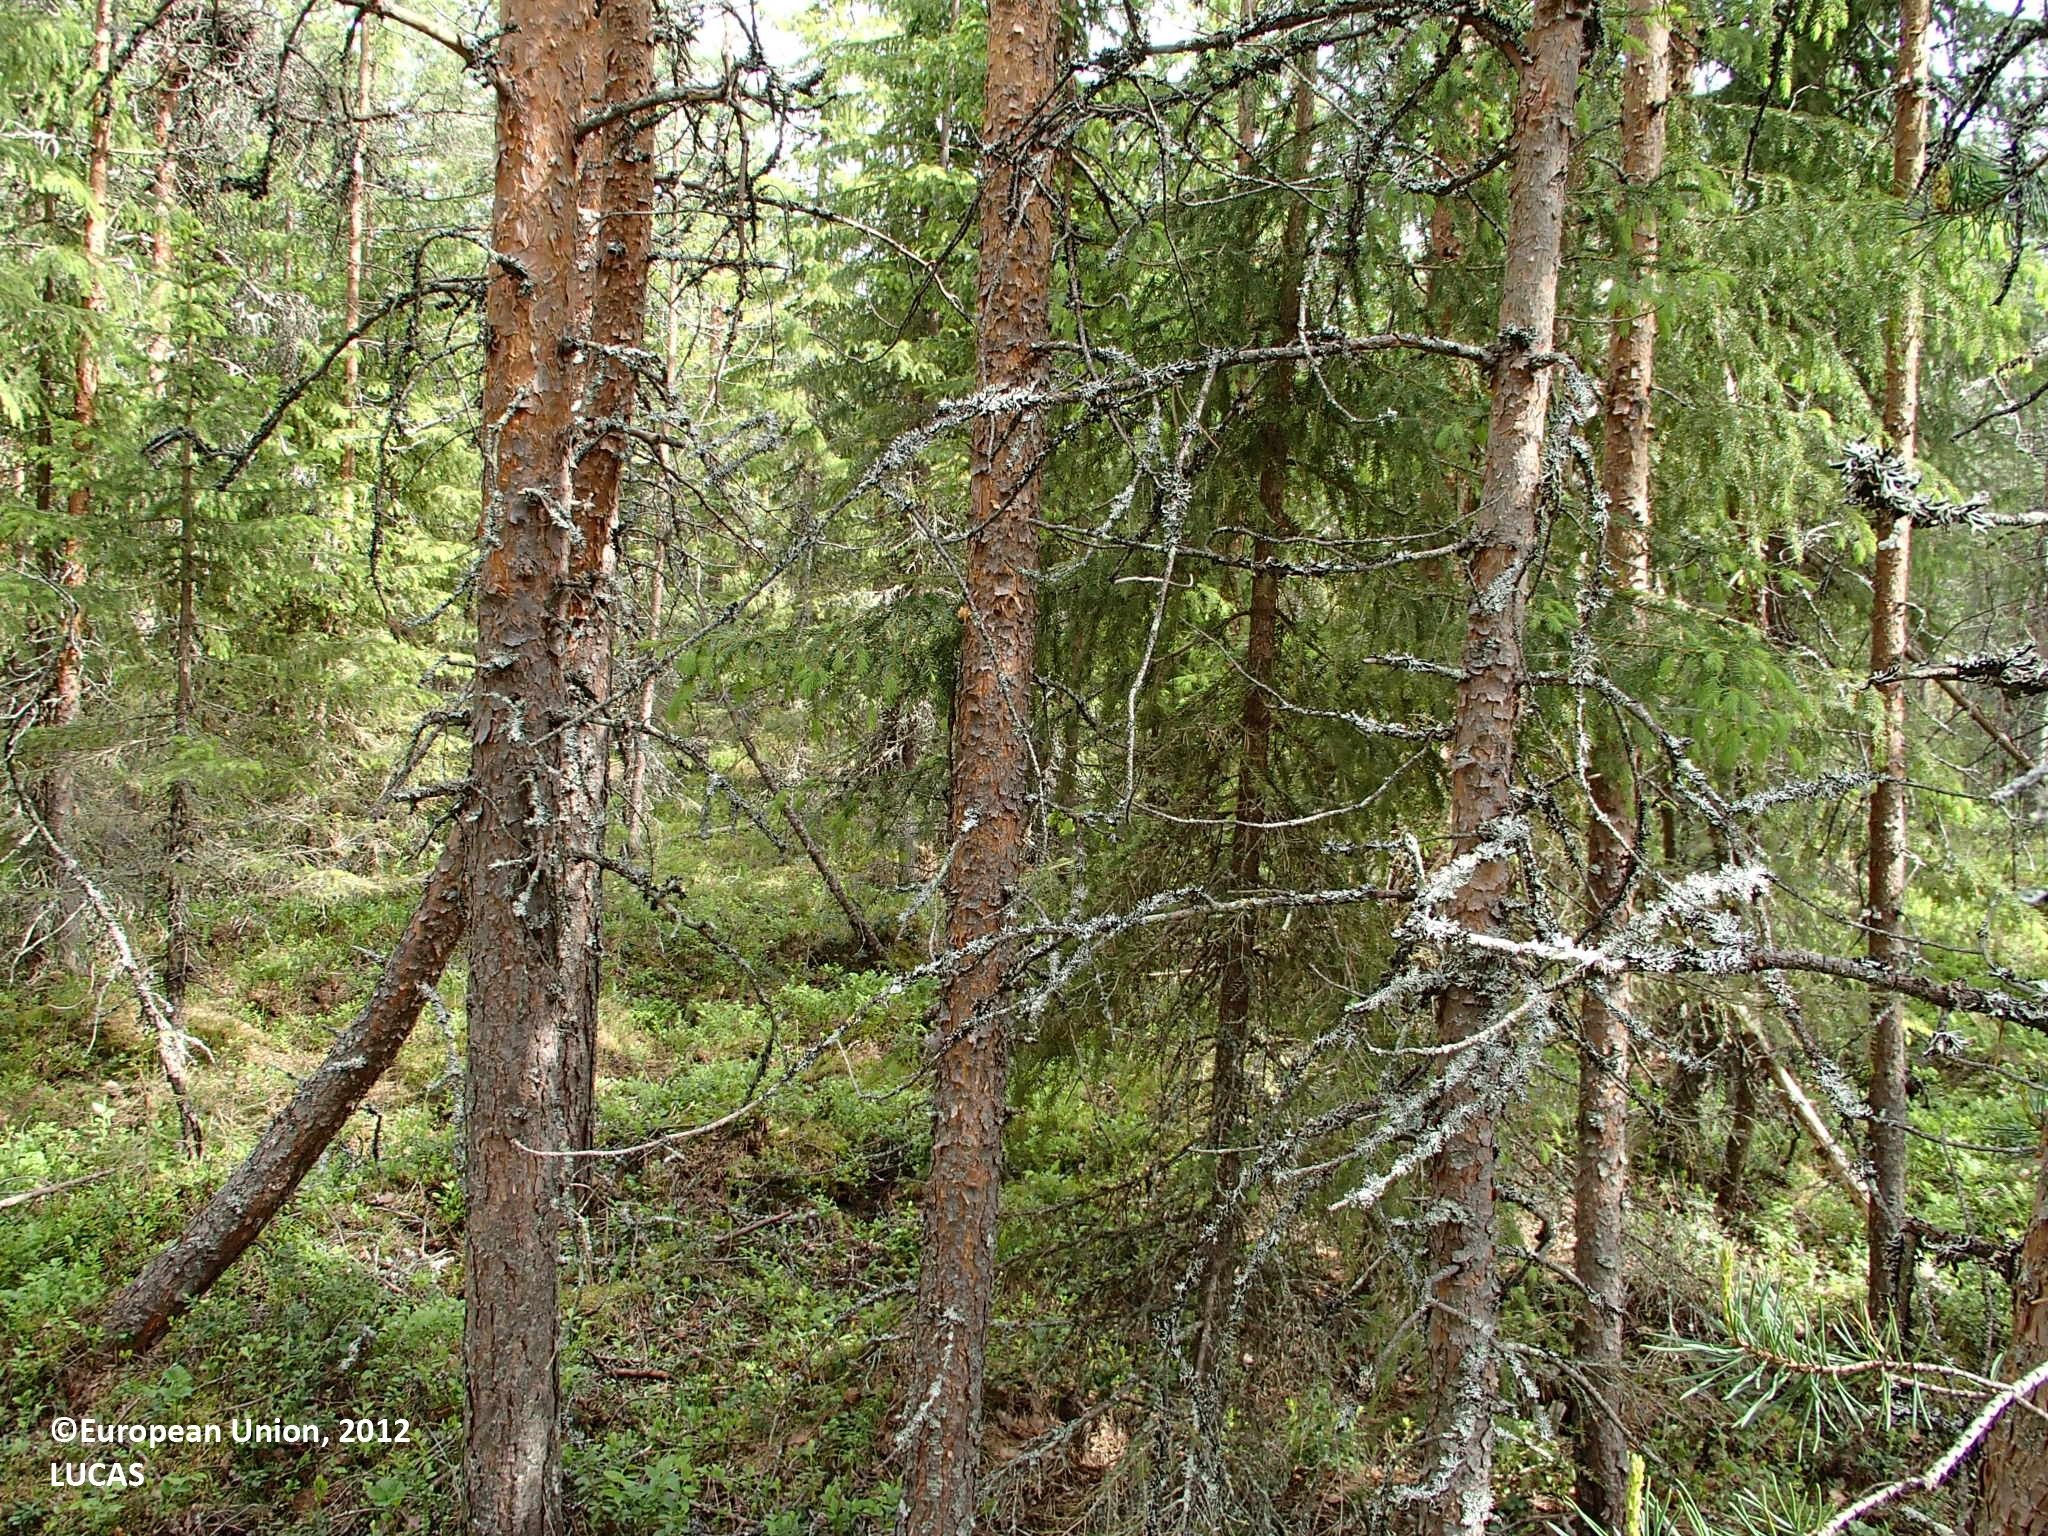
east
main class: Woodland
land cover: Pine dominated coniferous woodland
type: boreal forest
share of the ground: > 75 %
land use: Forestry
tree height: > 5 m
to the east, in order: Pine dominated coniferous woodland; Ditches and canals; Pine dominated coniferous woodland; Ditches and canals; Pine dominated coniferous woodland; Ditches and canals; Pine dominated coniferous woodland; Ditches and canals; Pine dominated coniferous woodland
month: June
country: FI
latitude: 66.6041
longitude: 26.3535
